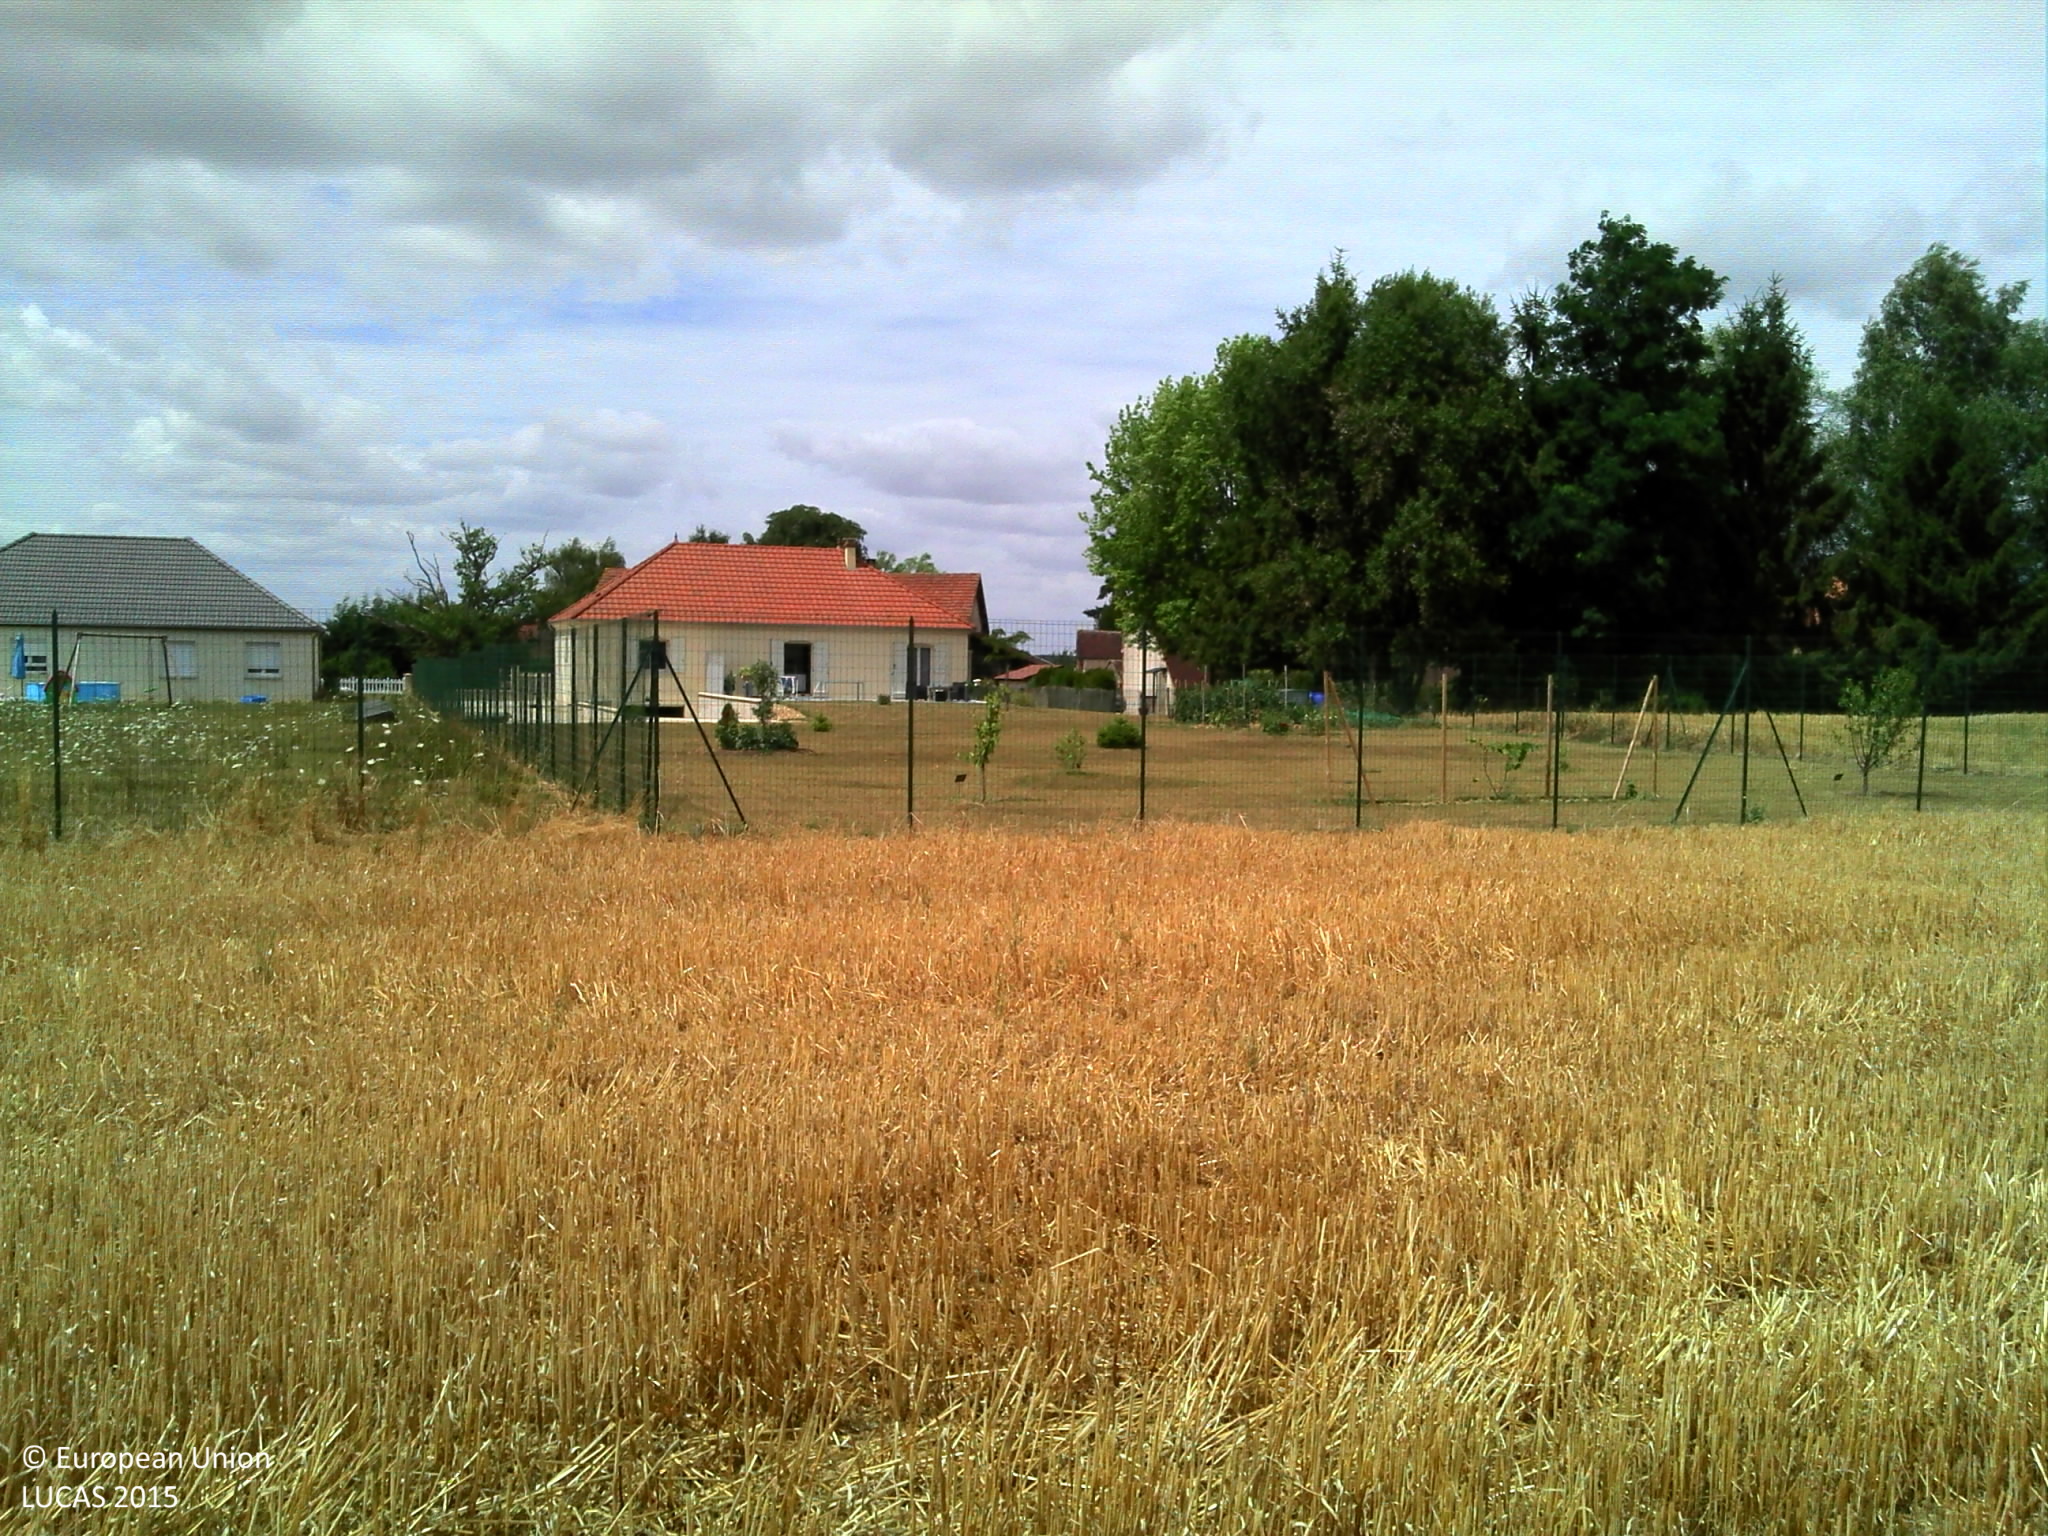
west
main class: Cropland
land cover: Barley
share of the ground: > 75 %
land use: Agriculture (excluding fallow land and kitchen gardens)
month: July
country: FR
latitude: 47.8813
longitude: 3.1071
